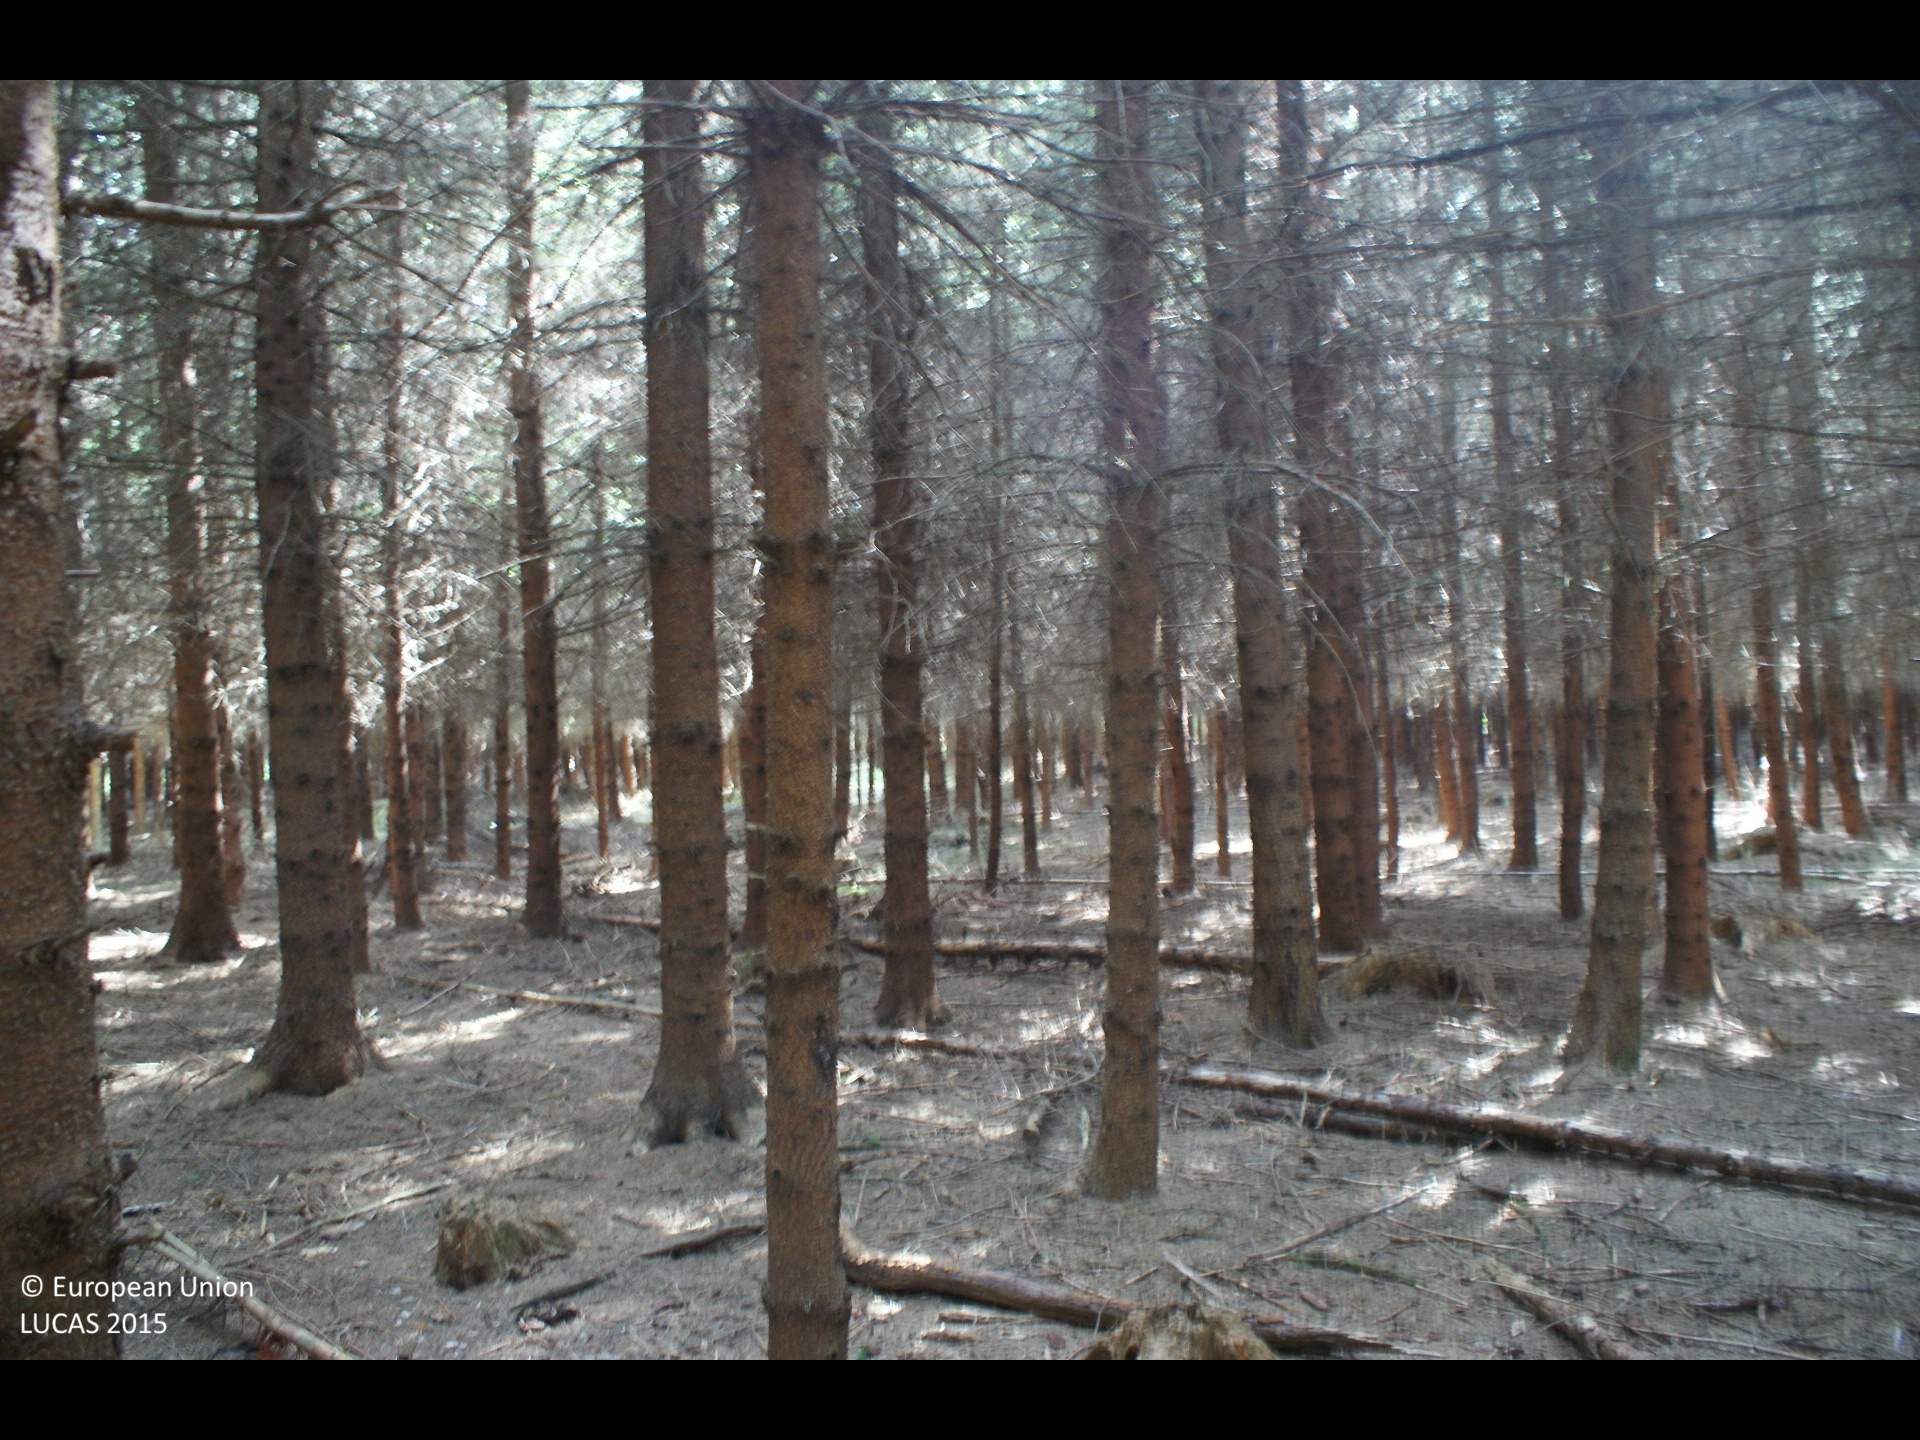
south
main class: Woodland
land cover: Spruce dominated coniferous woodland
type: hemiboreal forest and nemoral coniferous forest and mixed broadleaved-coniferous forest
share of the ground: > 75 %
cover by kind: coniferous forest trees 95 %, unconsolidated bare surface 5 %
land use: Forestry
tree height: > 5 m
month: August
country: AT
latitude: 47.9971
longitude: 13.7651
